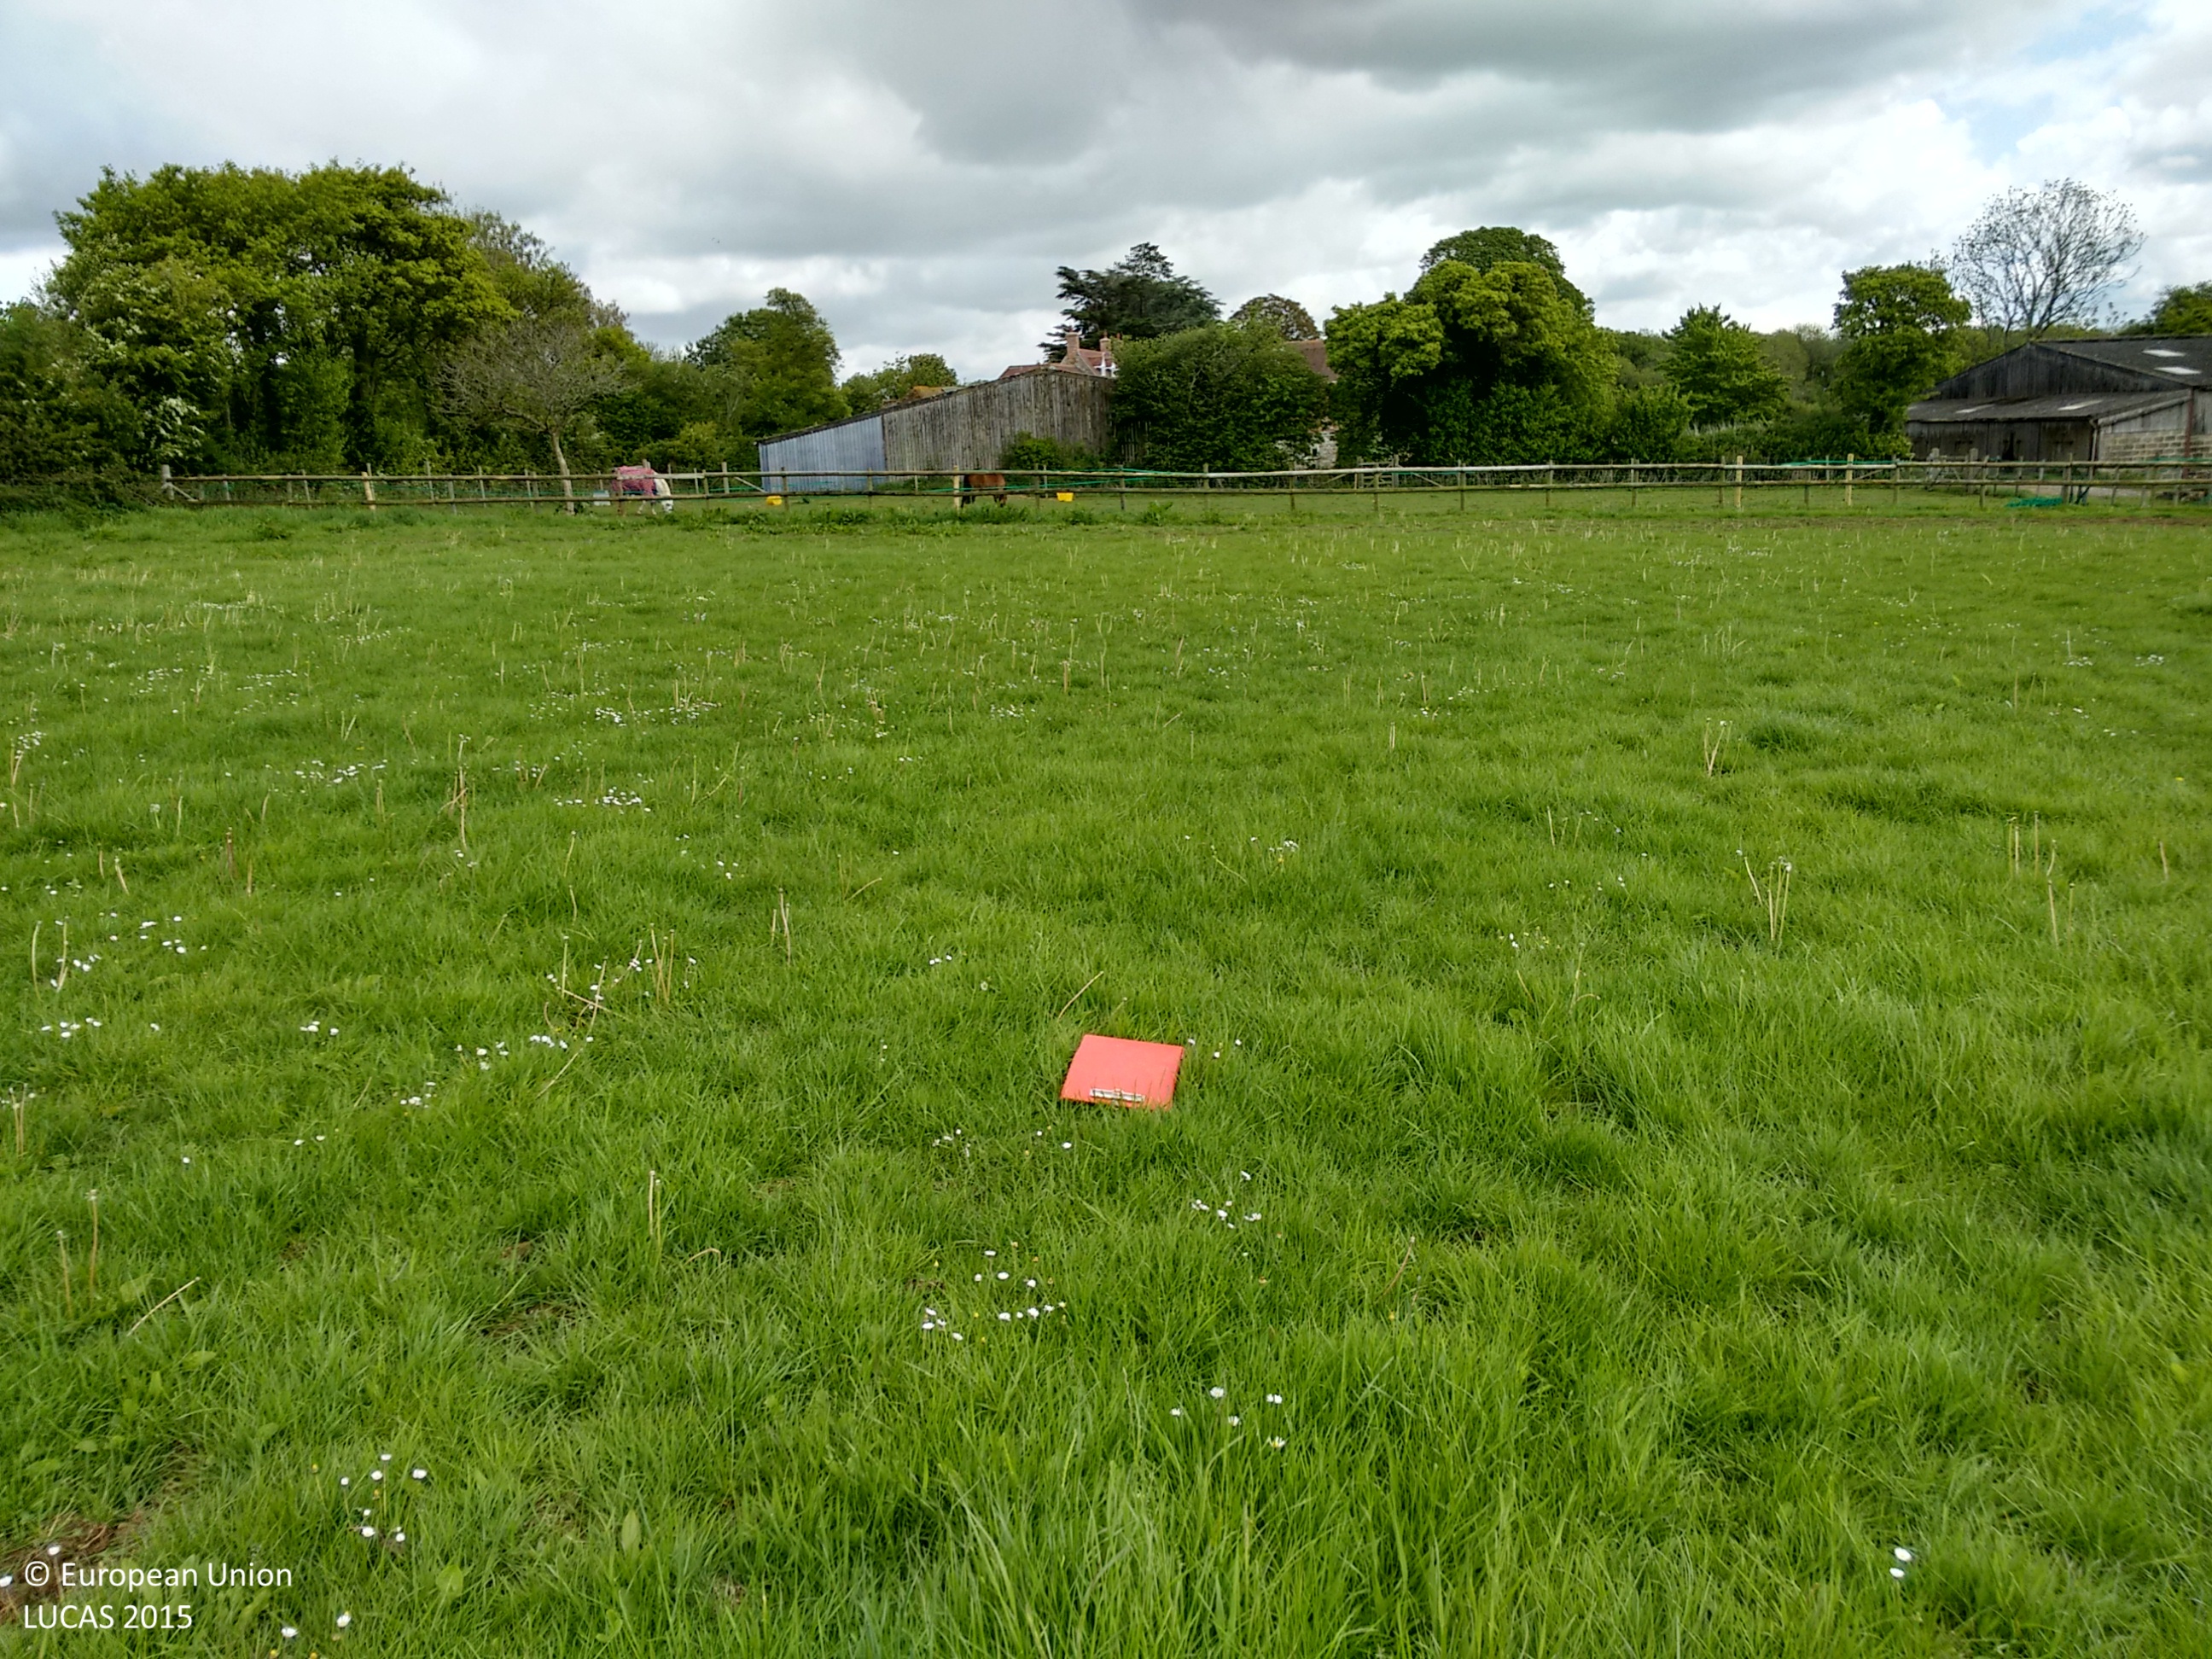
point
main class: Grassland
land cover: Grassland without tree/shrub cover
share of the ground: > 75 %
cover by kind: herbaceous plants 100 %
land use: Agriculture (excluding fallow land and kitchen gardens)
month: May
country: GB
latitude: 50.9383
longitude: -2.4317
